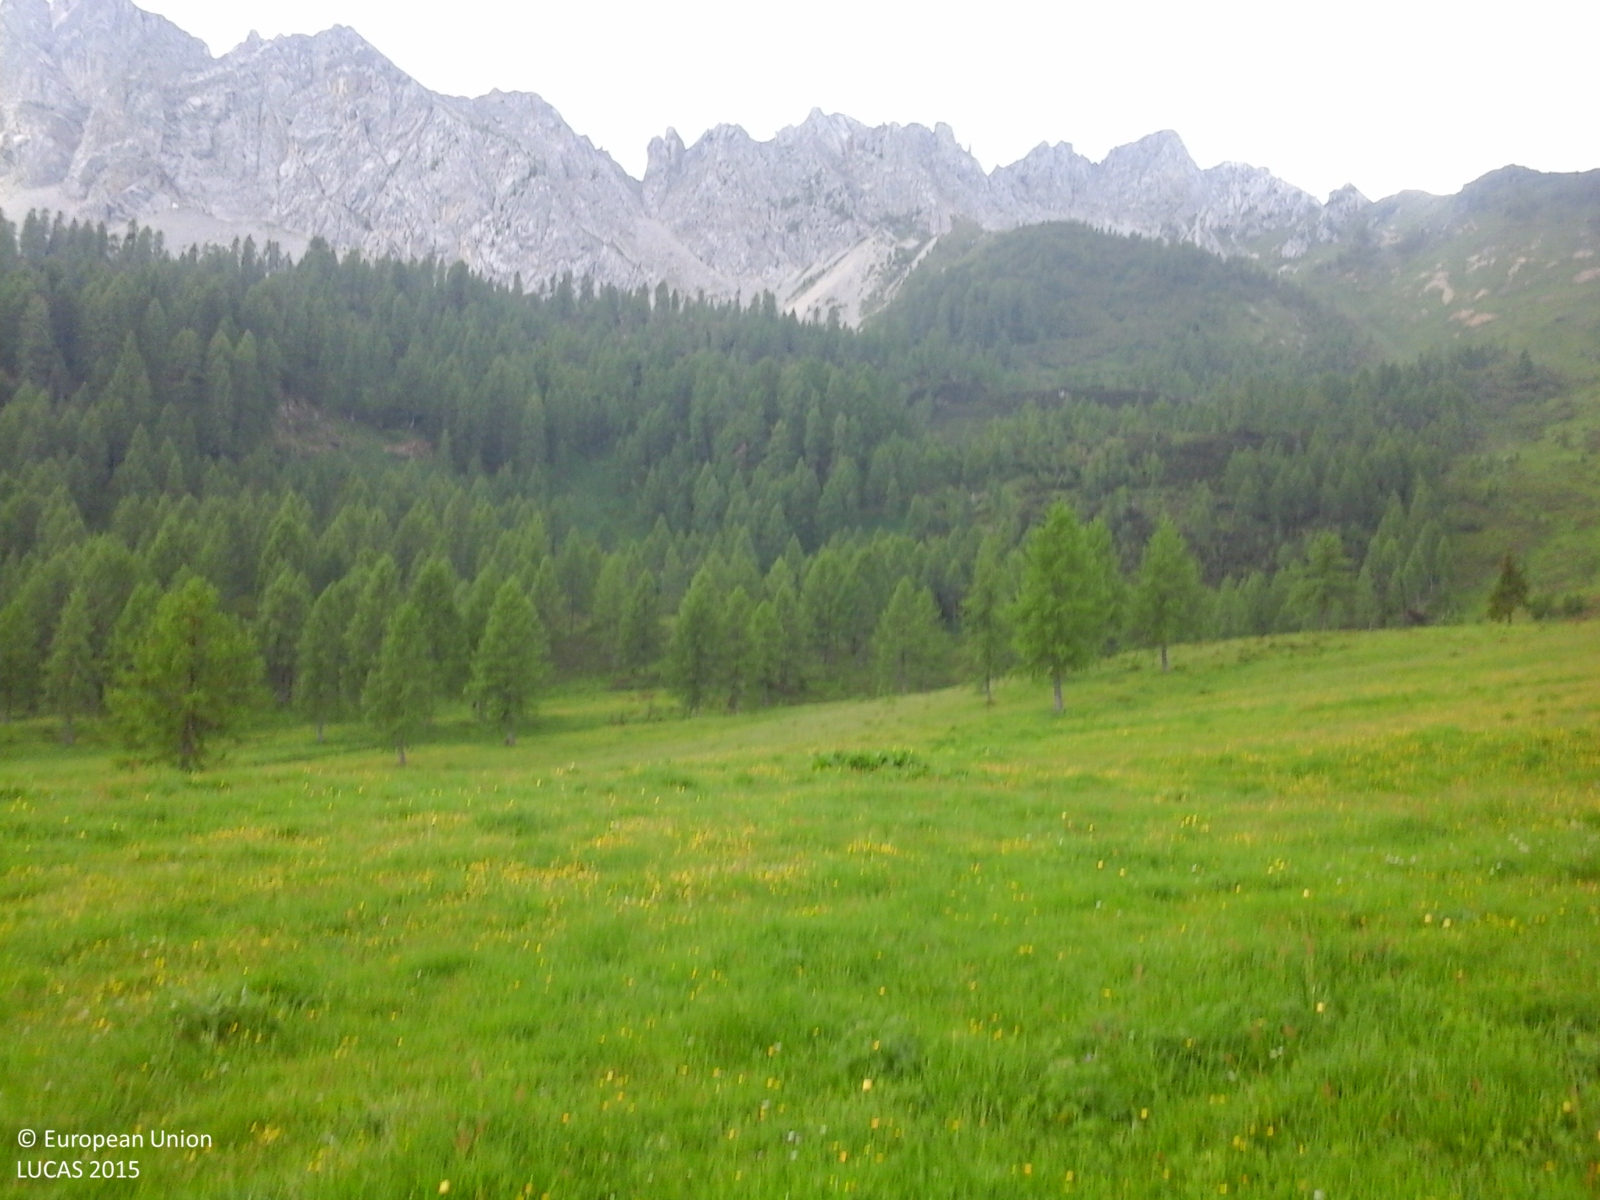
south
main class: Grassland
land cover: Grassland without tree/shrub cover
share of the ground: > 75 %
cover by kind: herbaceous plants 100 %
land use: Agriculture (excluding fallow land and kitchen gardens)
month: June
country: IT
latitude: 46.4821
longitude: 12.5894
